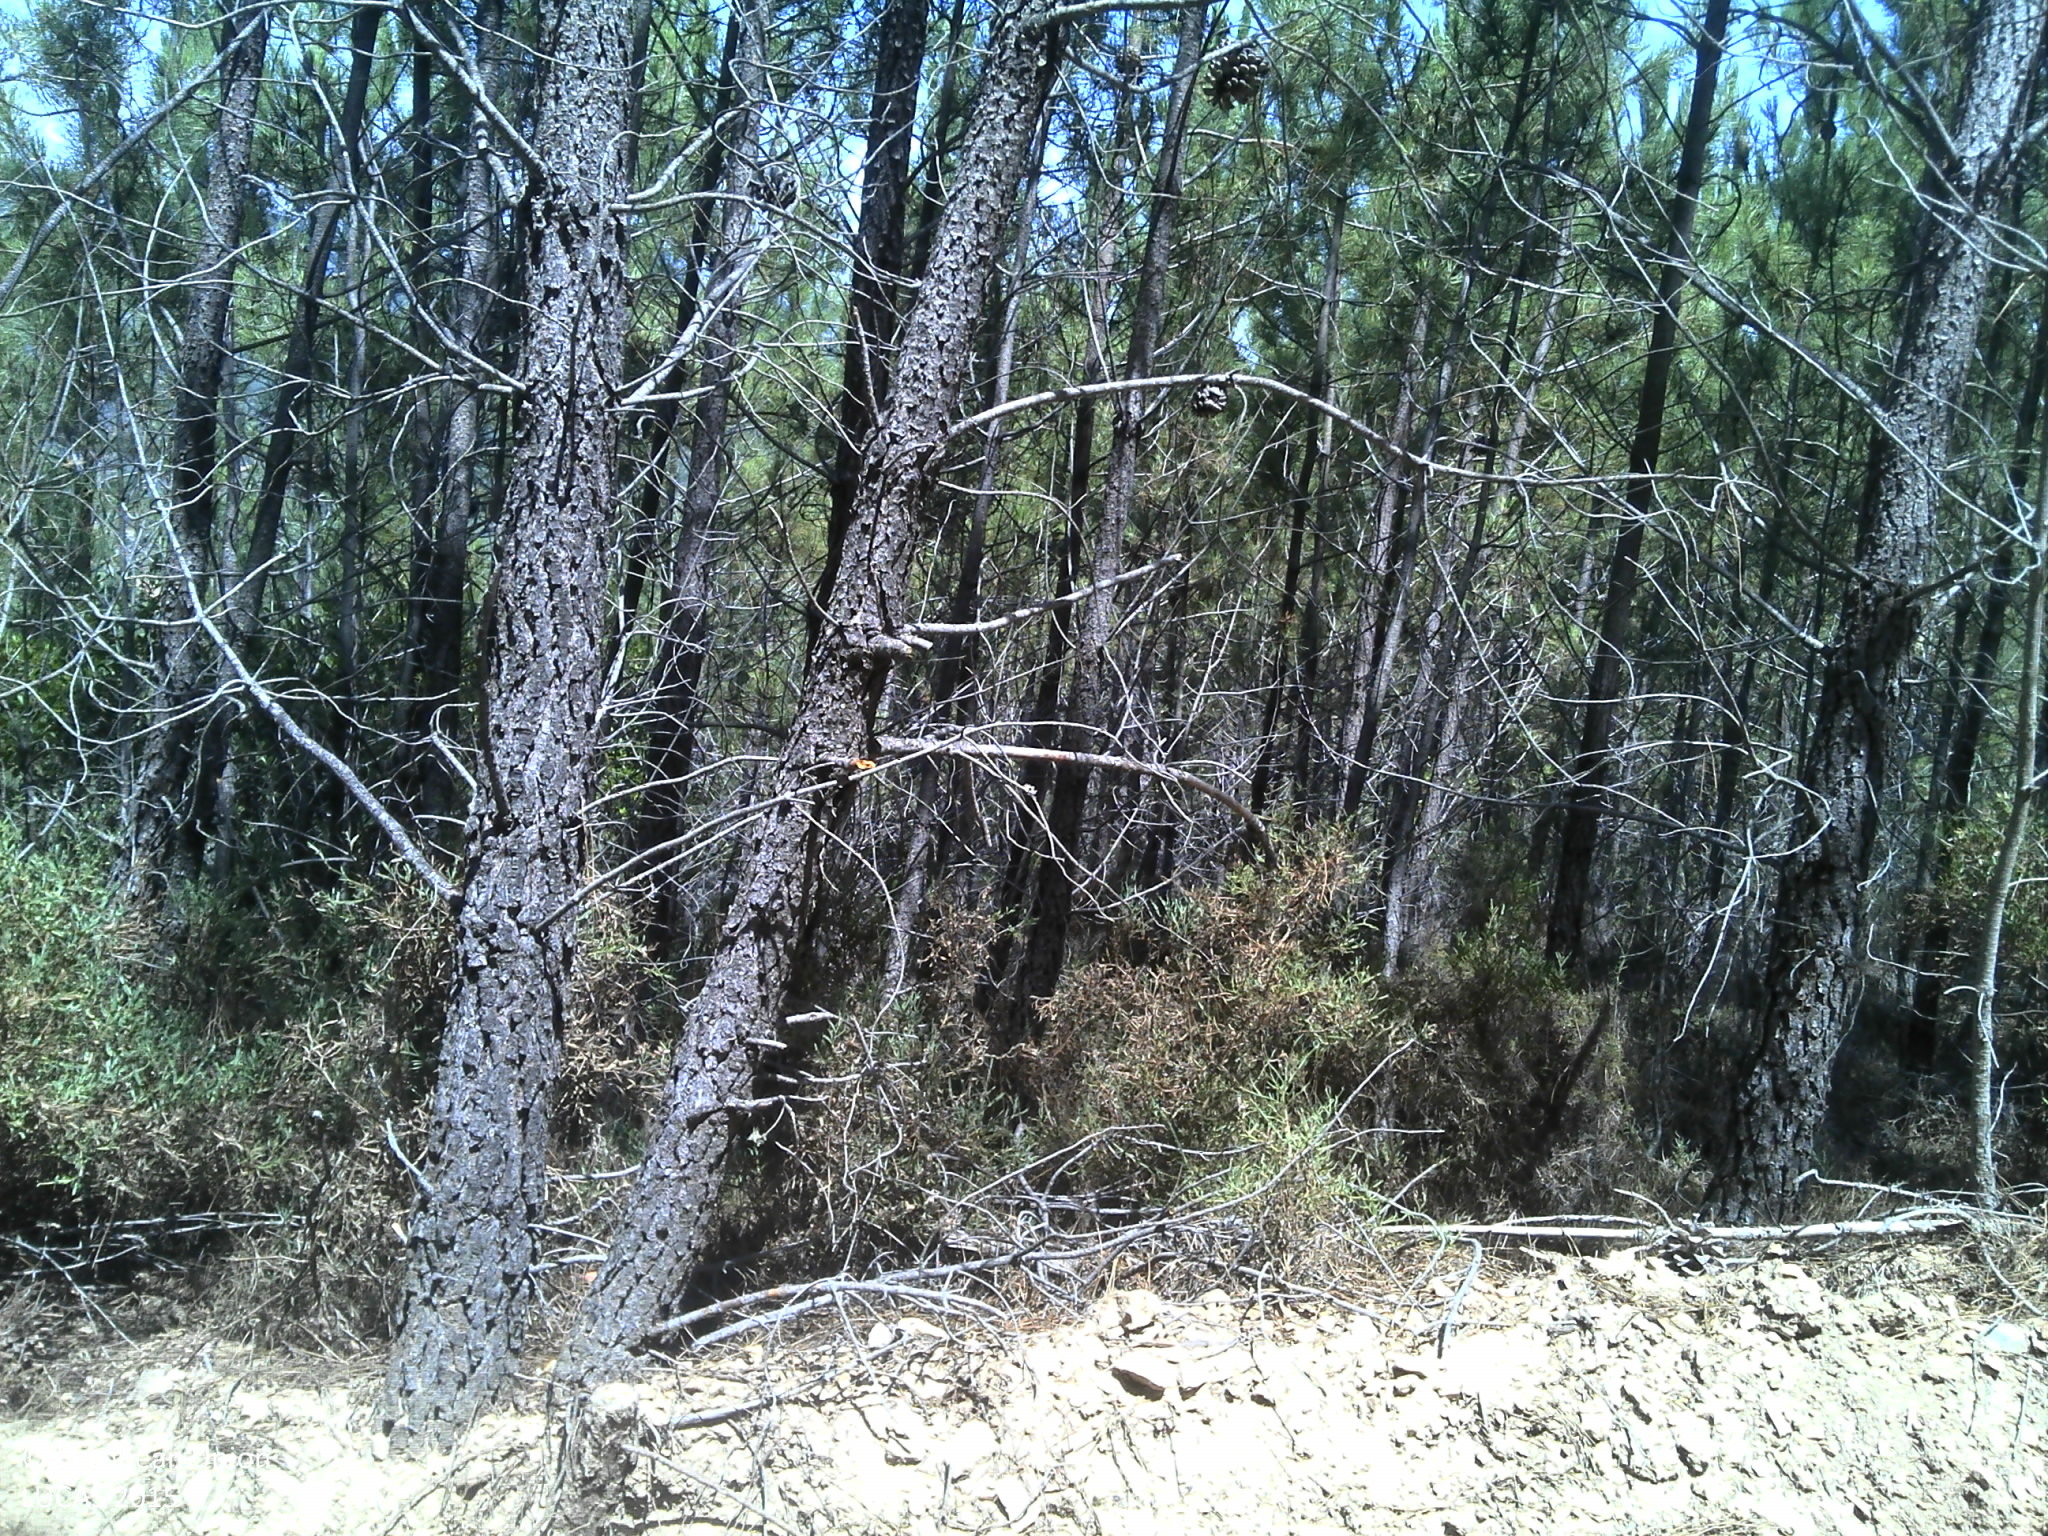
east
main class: Woodland
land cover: Pine dominated coniferous woodland
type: coniferous forest of the mediterranean region
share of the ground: 50 - 75 %
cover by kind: coniferous forest trees 75 %, shrubs 20 %
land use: Forestry
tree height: > 5 m
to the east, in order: Pine dominated coniferous woodland; Tracks; Pine dominated coniferous woodland; Grass margins; Paved roads, cycling and walking lanes; Grass margins; Pine dominated coniferous woodland; Tracks
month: July
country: PT
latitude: 39.9287
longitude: -7.7407
